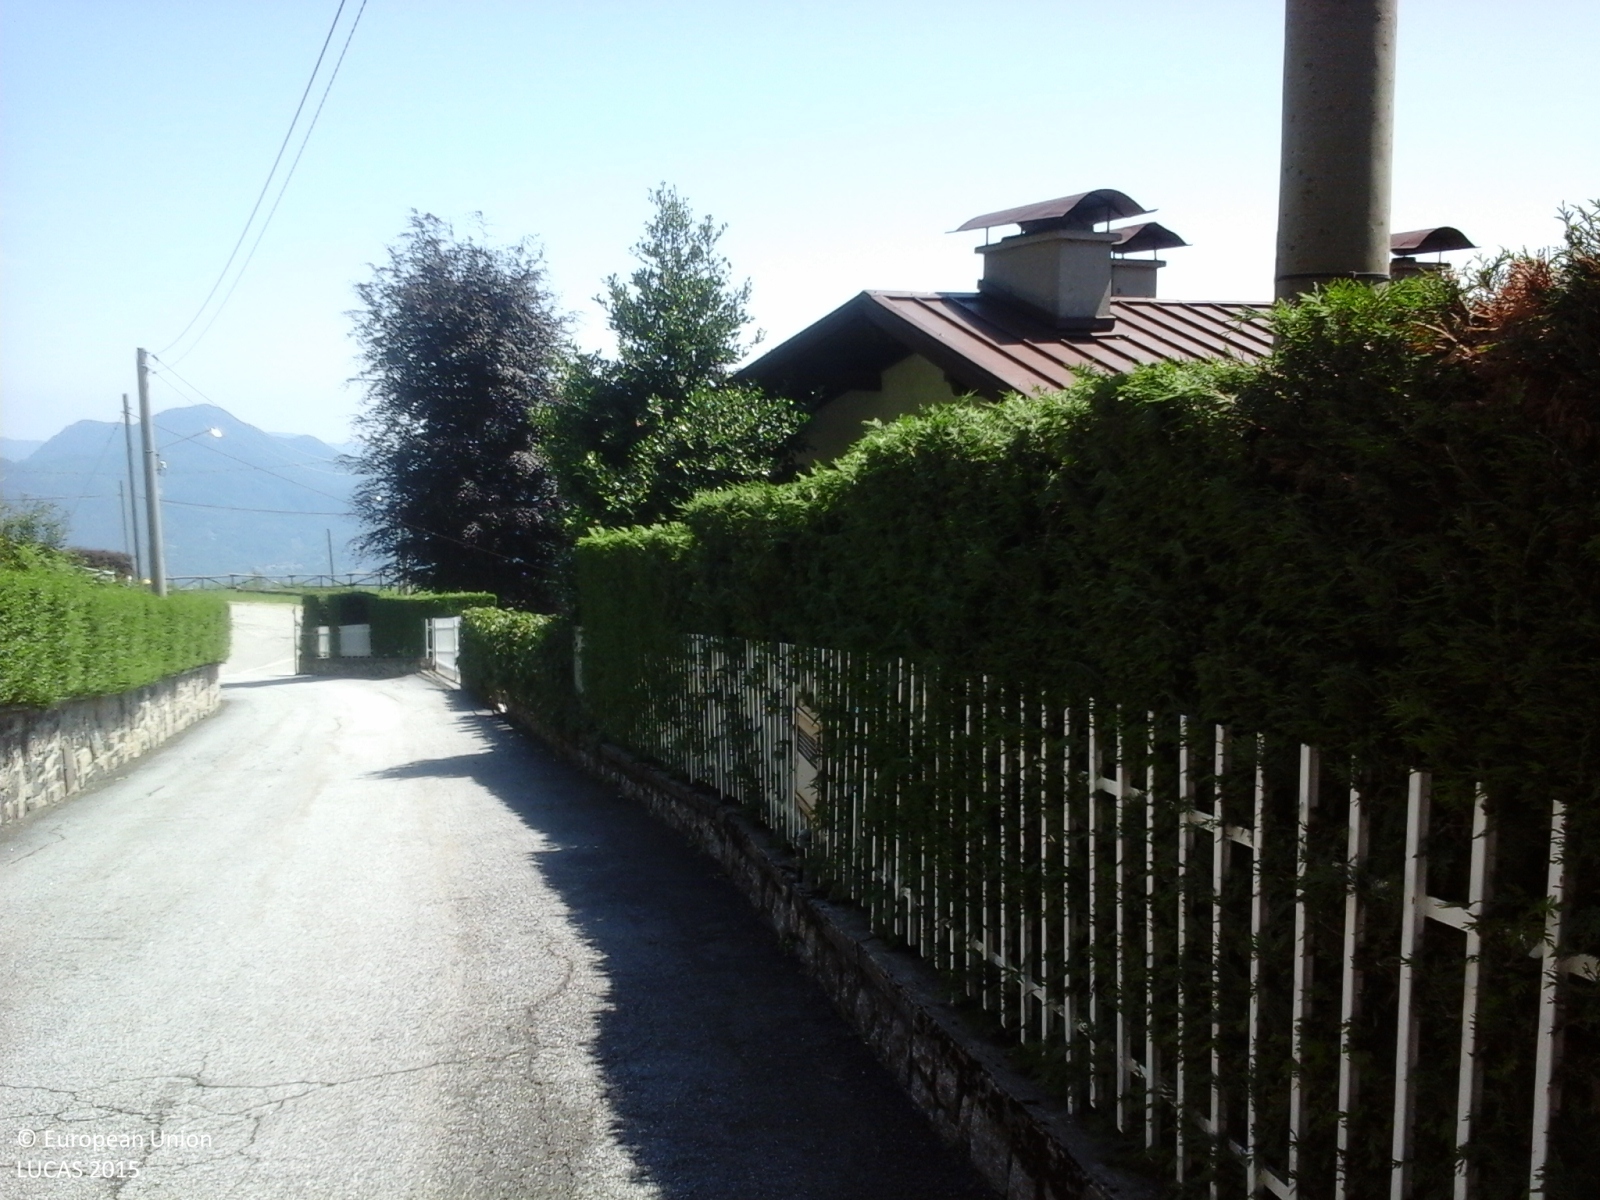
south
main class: Woodland
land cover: Broadleaved woodland
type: thermophilous deciduous forest
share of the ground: > 75 %
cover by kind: broadleaved forest trees 100 %
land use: Forestry
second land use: Amenities, museums, leisure
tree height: > 5 m
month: June
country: IT
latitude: 45.9816
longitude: 8.5950
